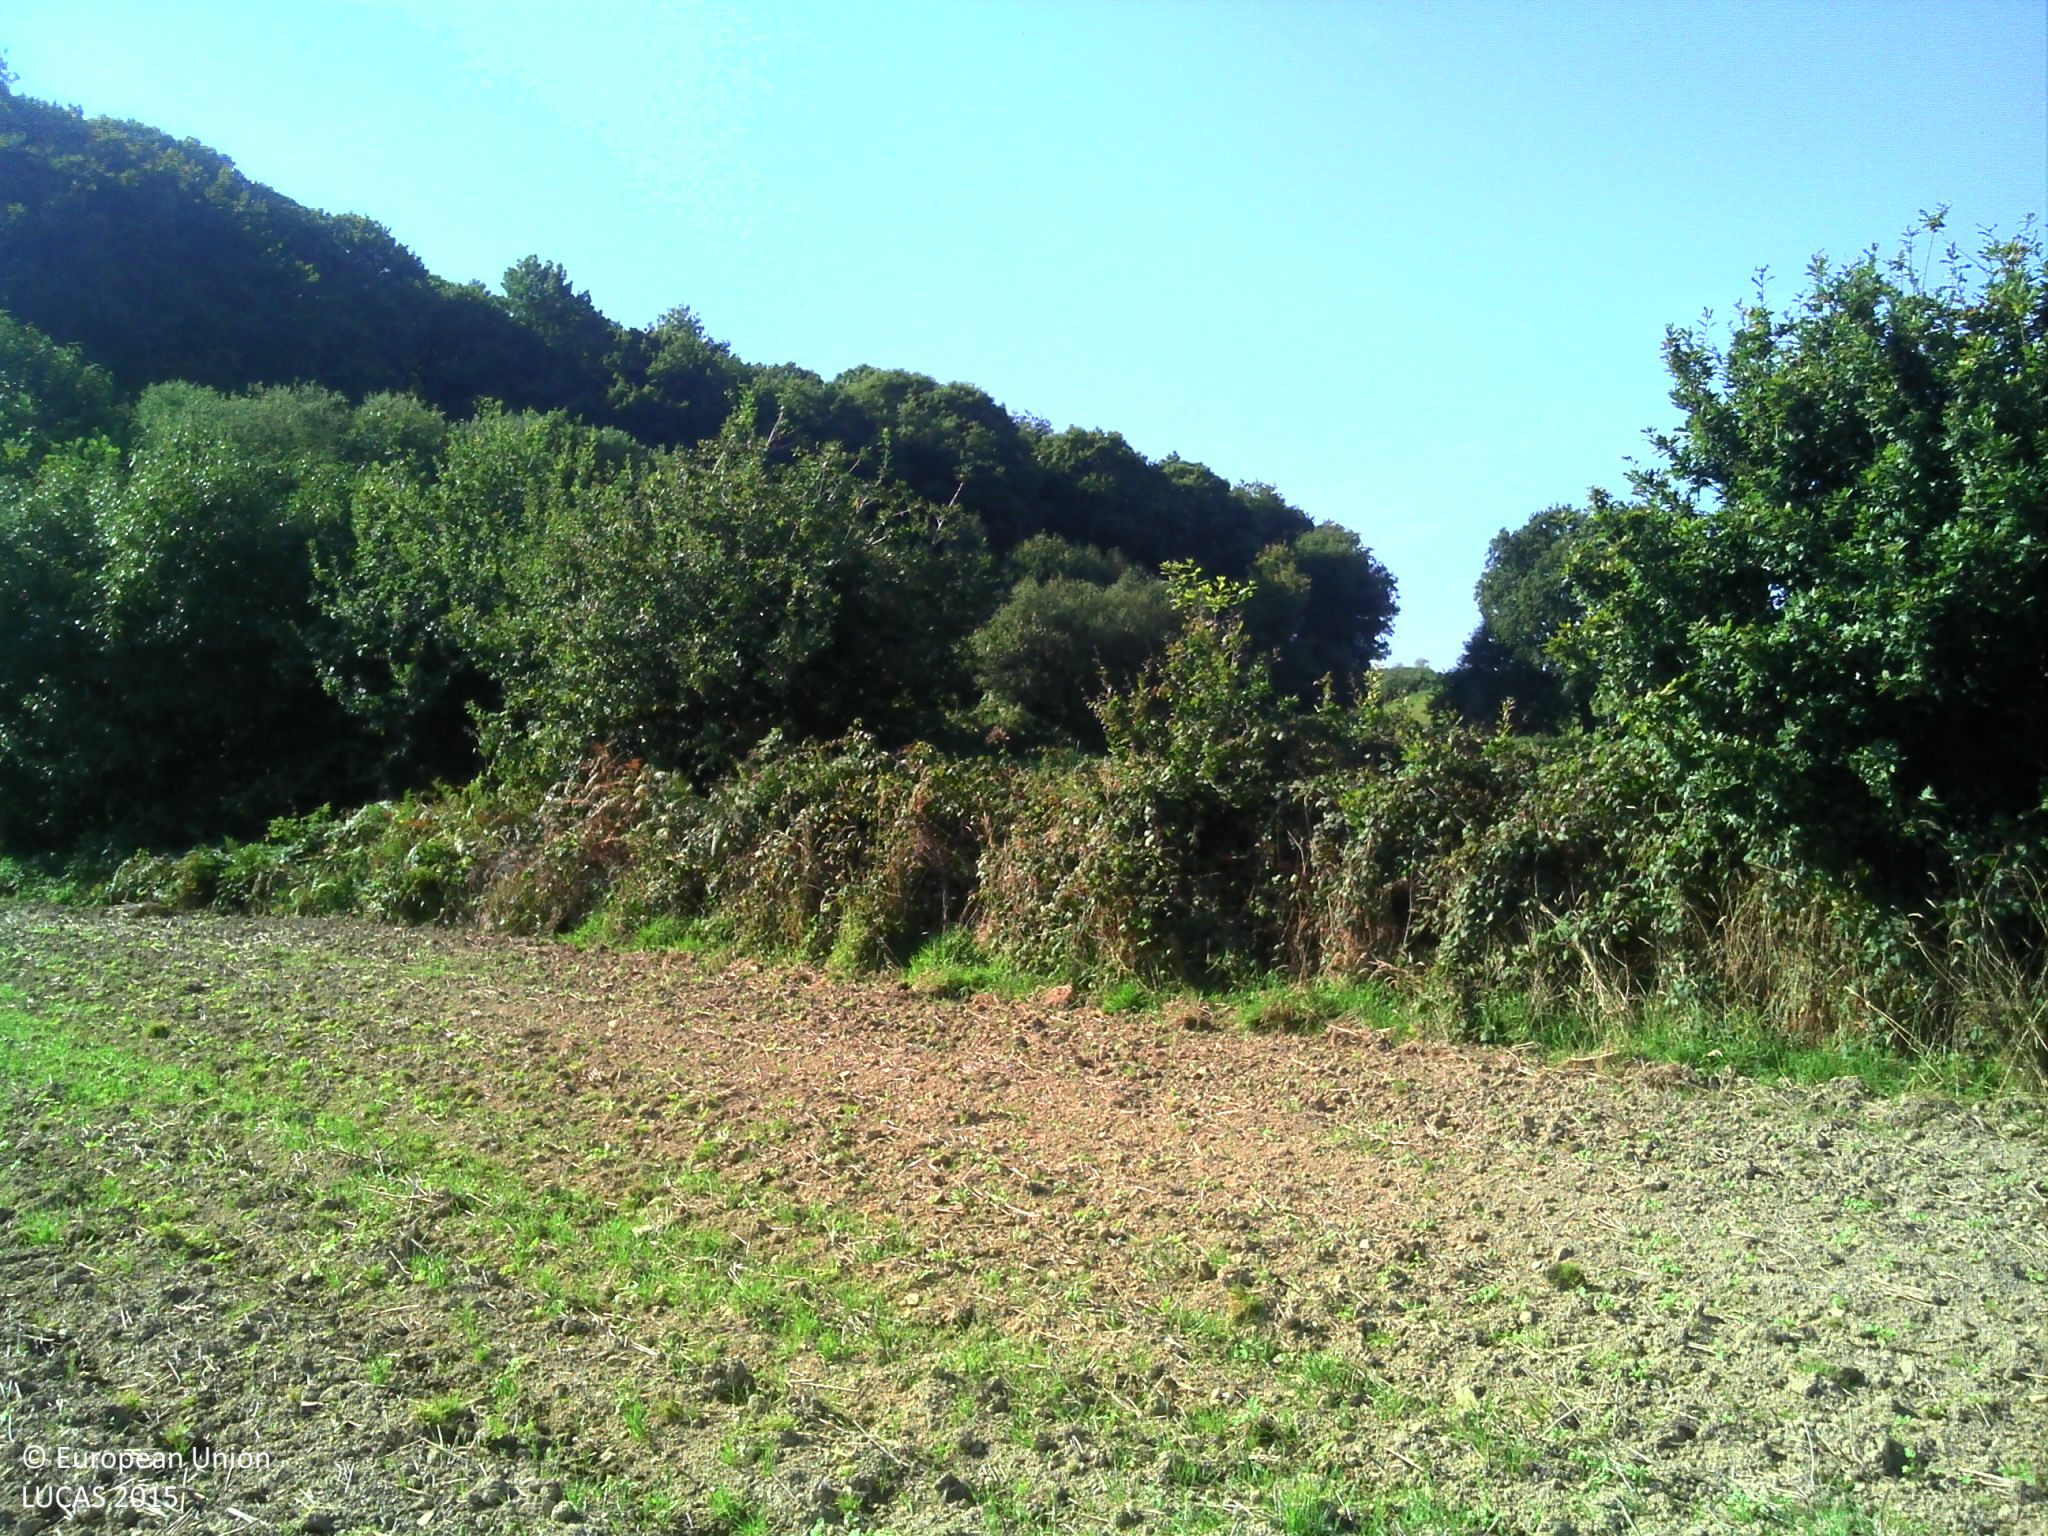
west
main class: Cropland
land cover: Rape and turnip rape
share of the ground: 10 - 25 %
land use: Agriculture (excluding fallow land and kitchen gardens)
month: October
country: FR
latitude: 48.4560
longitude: -3.1206
